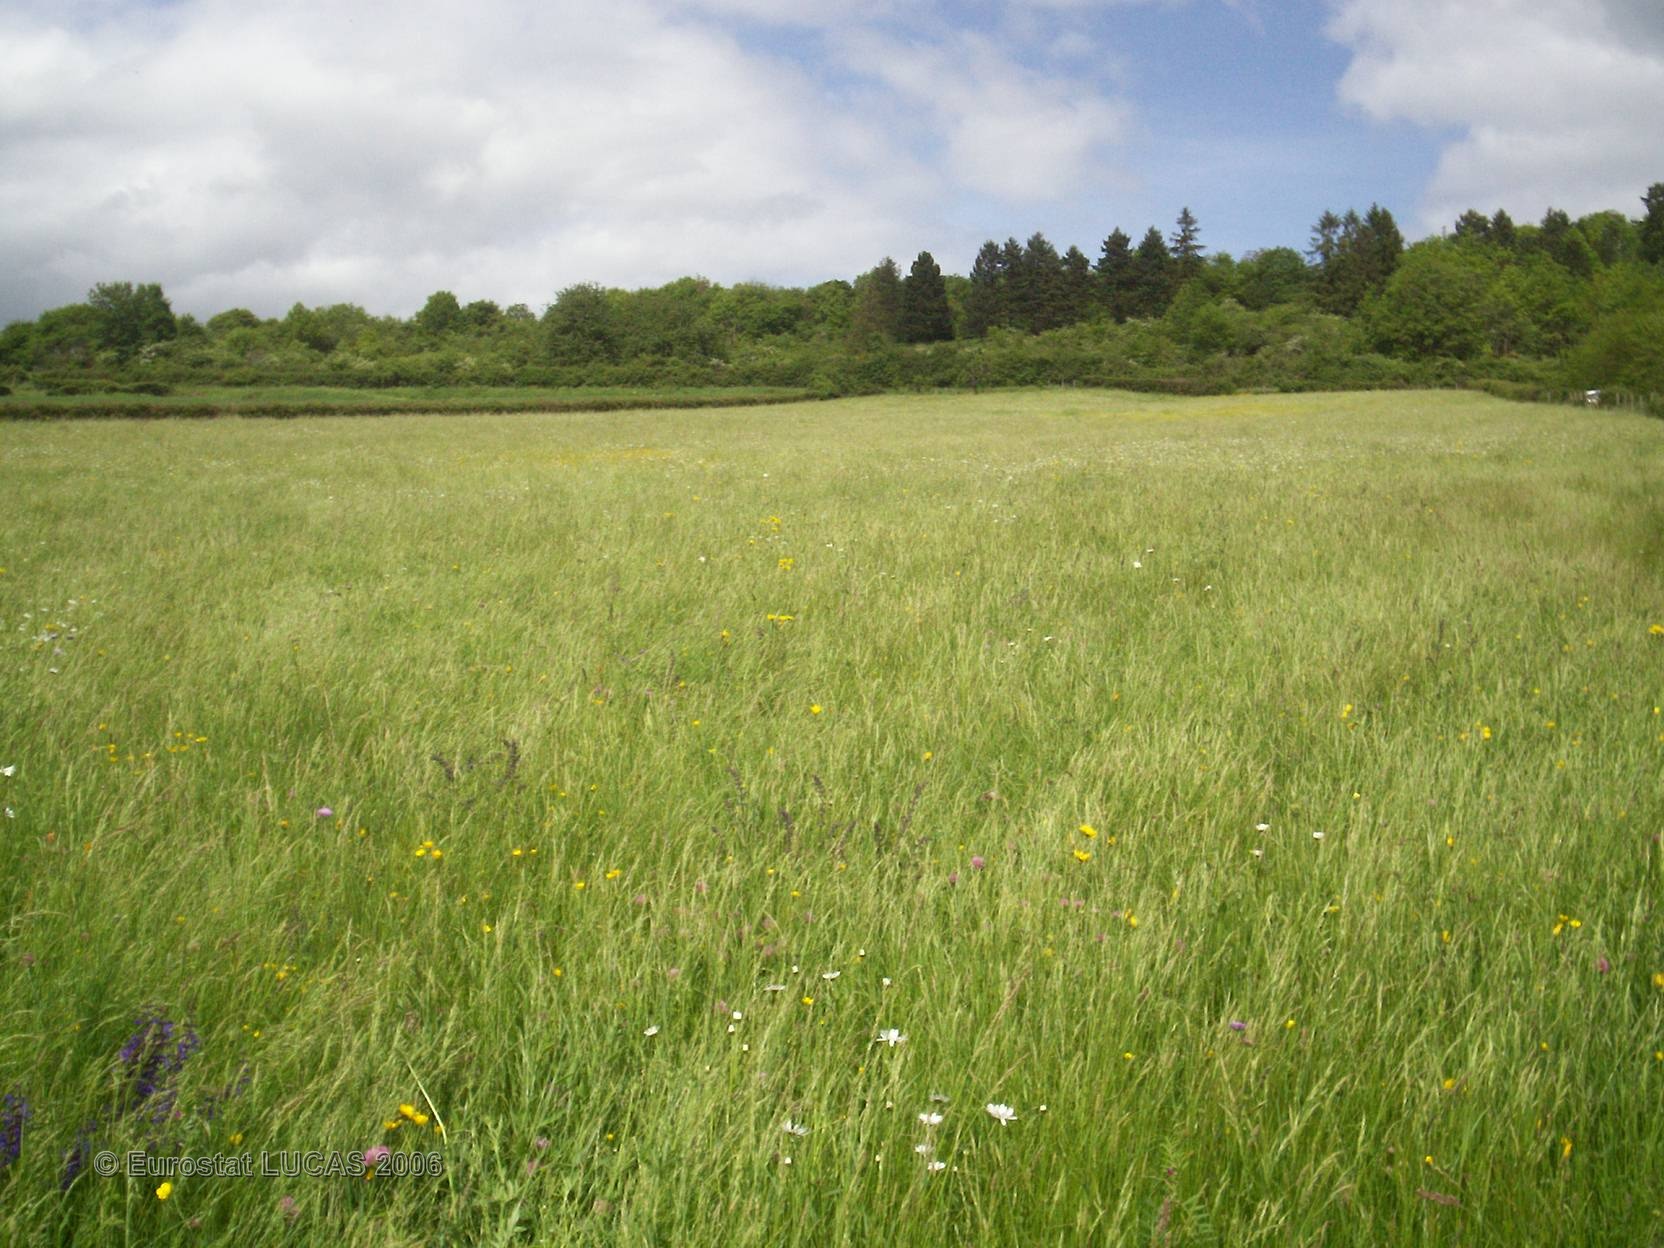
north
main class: Grassland
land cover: Grassland without tree/shrub cover
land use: Agriculture (excluding fallow land and kitchen gardens)
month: May
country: FR
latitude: 47.1382
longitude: 4.6602
